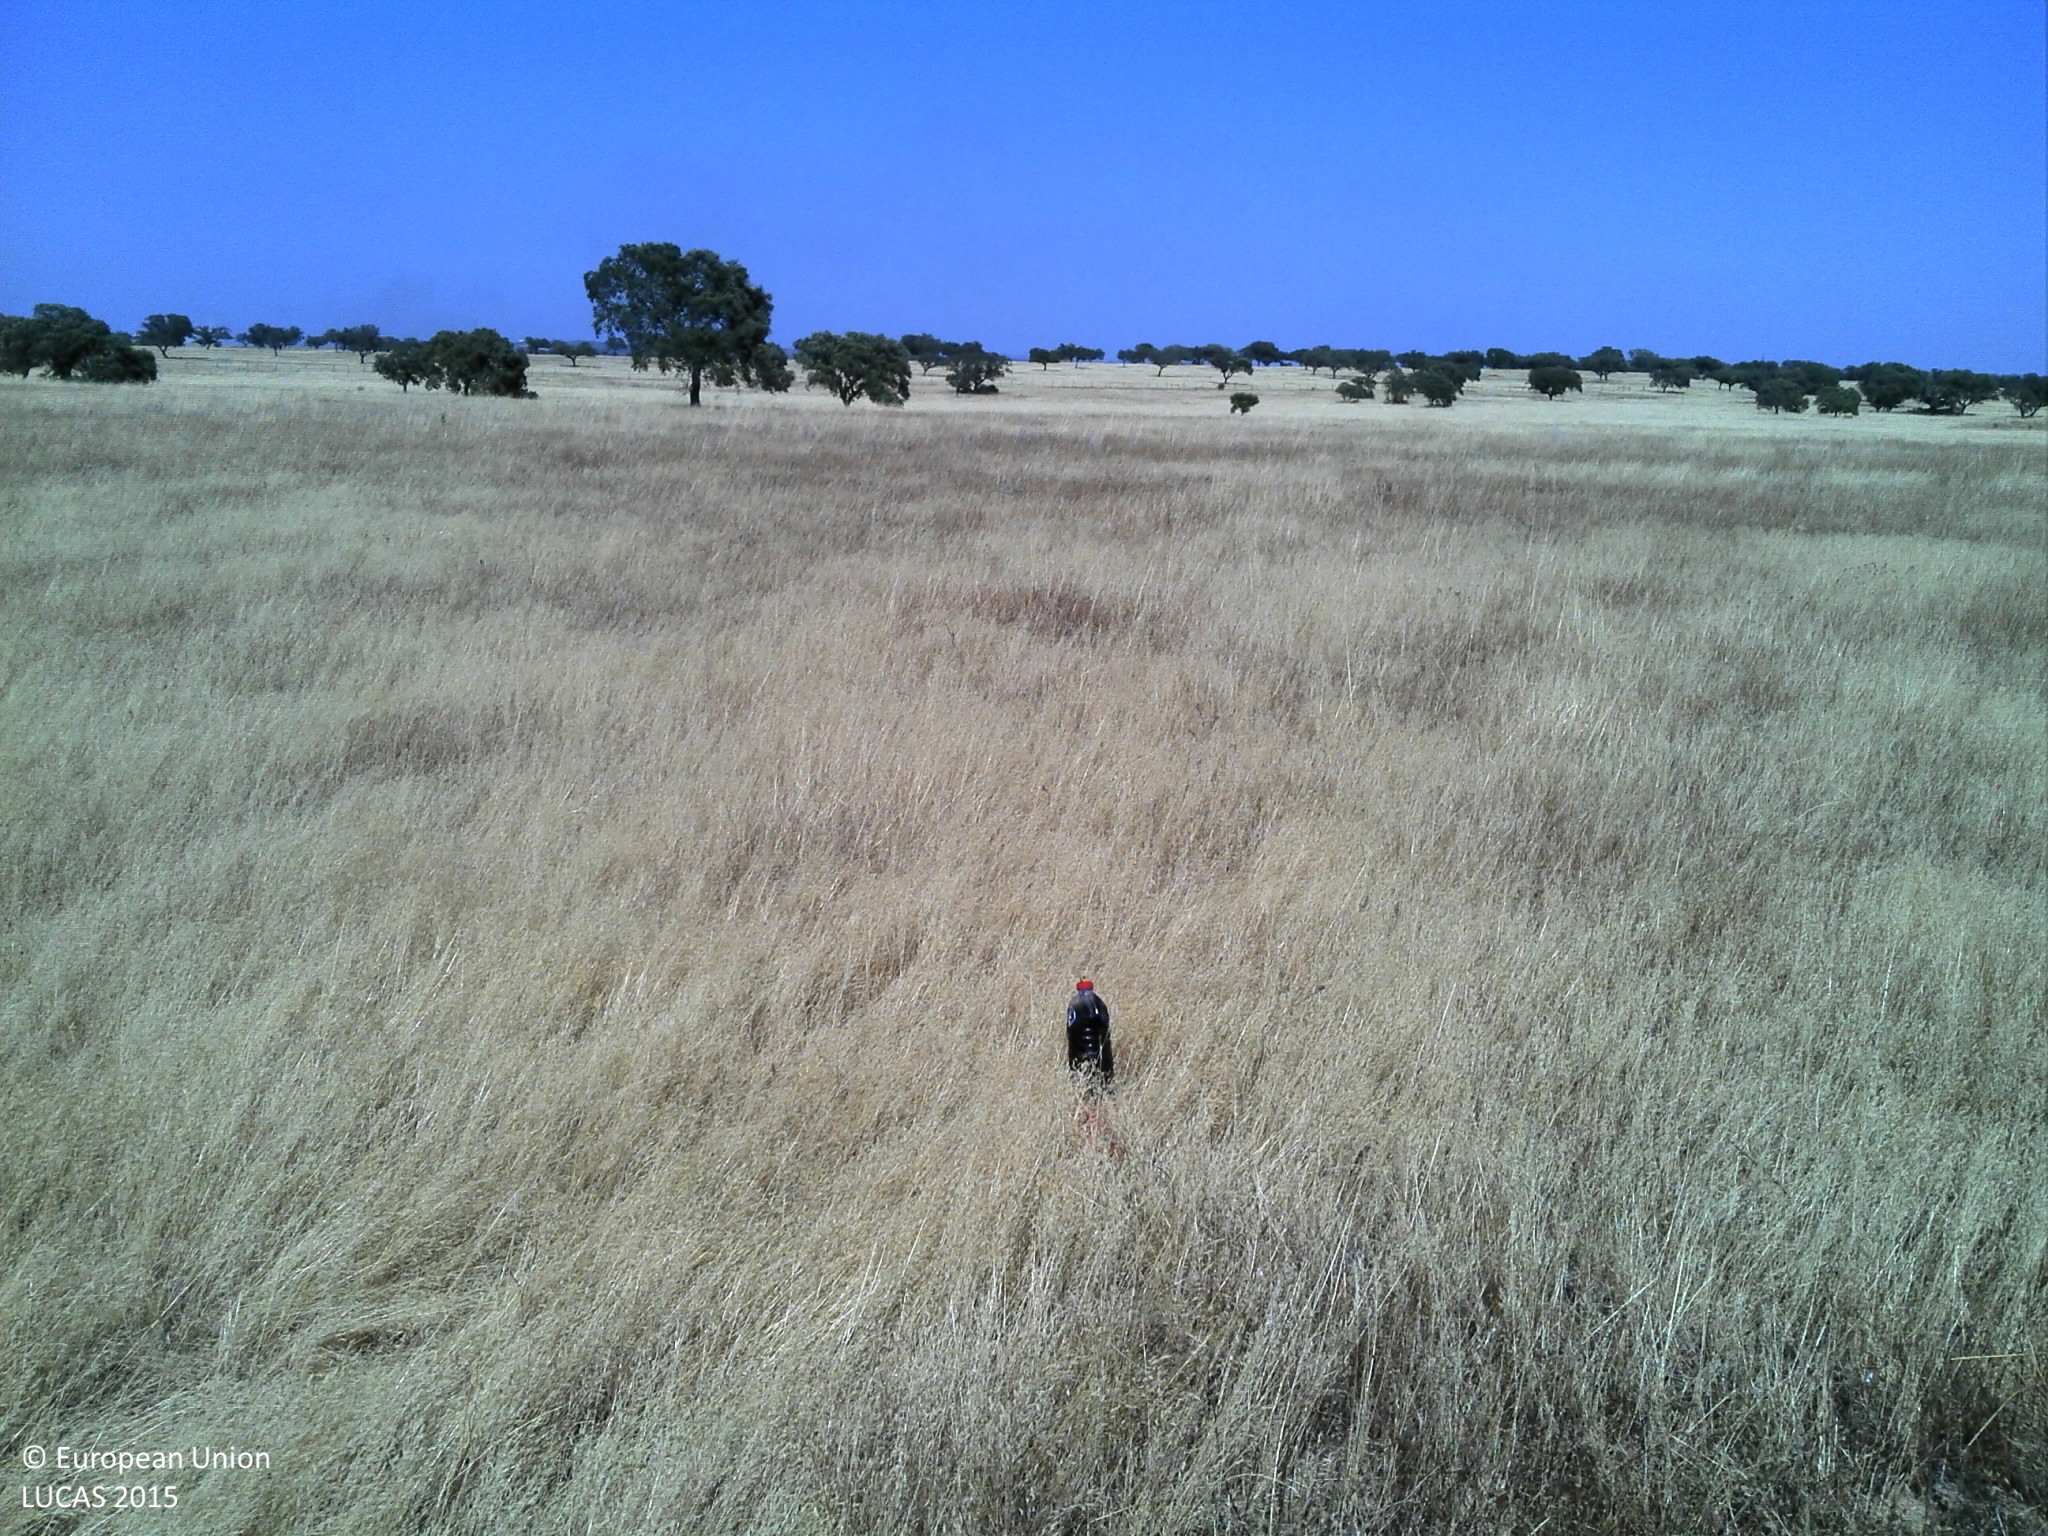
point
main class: Grassland
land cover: Grassland without tree/shrub cover
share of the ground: > 75 %
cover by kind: herbaceous plants 85 %, unconsolidated bare surface 15 %
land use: Agriculture (excluding fallow land and kitchen gardens)
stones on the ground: < 10 %
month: June
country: PT
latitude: 38.2084
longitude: -8.0458
